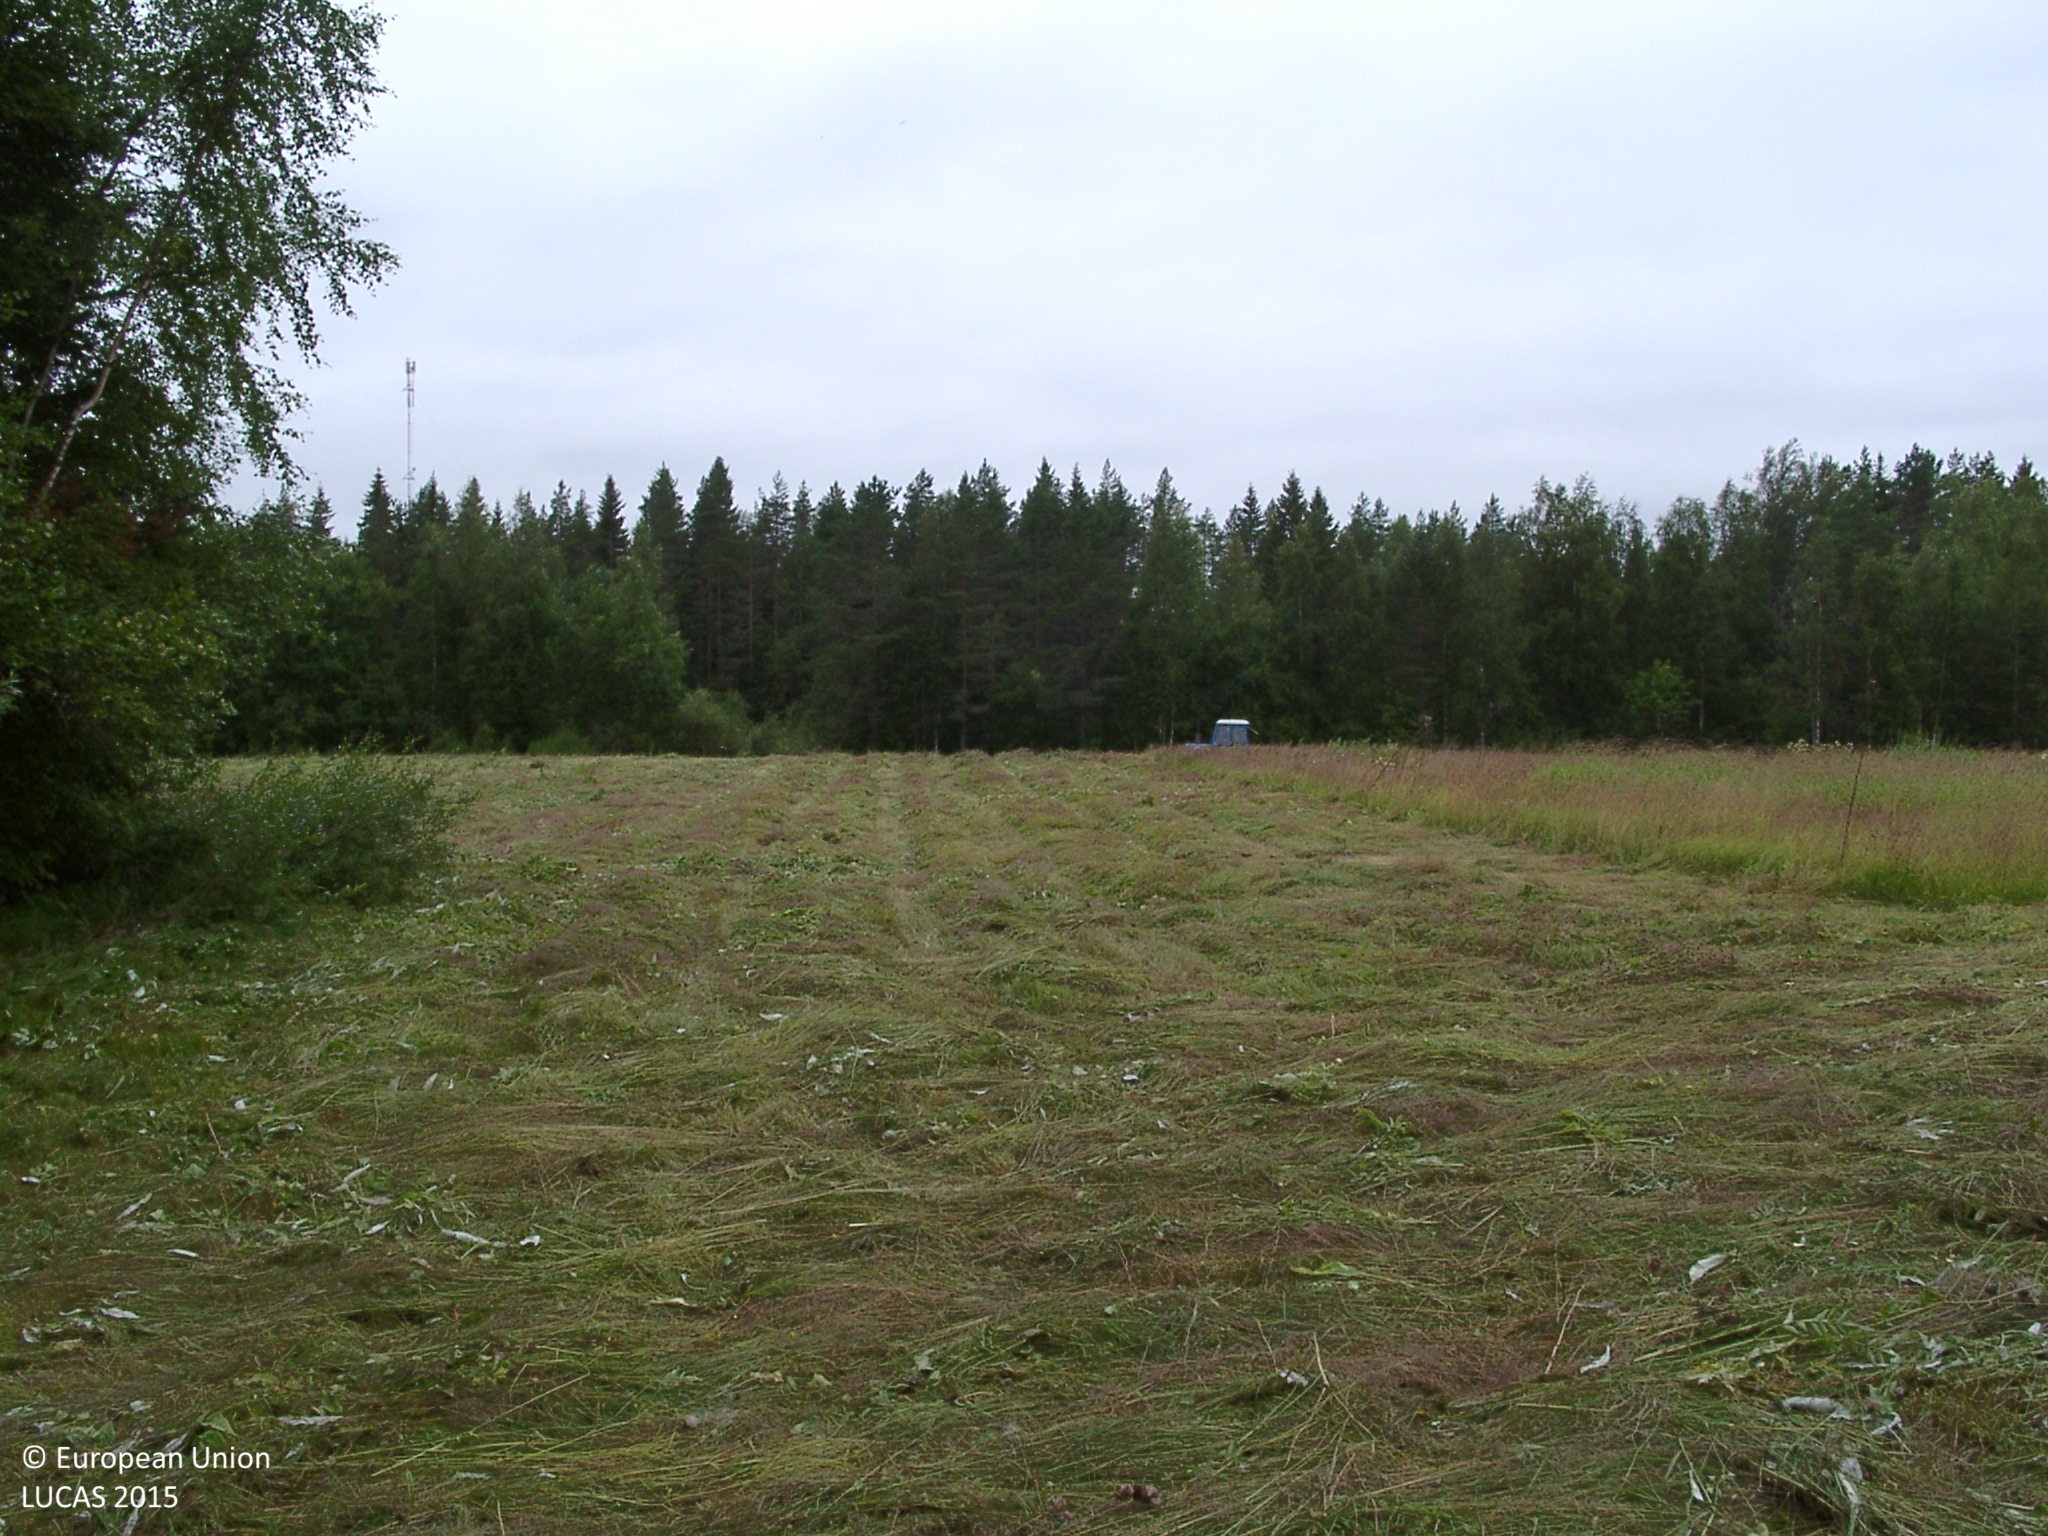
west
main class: Grassland
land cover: Spontaneously vegetated surfaces
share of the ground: > 75 %
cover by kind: herbaceous plants 100 %
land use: Fallow land
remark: Harvested field
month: August
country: FI
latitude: 62.6898
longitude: 24.5660
